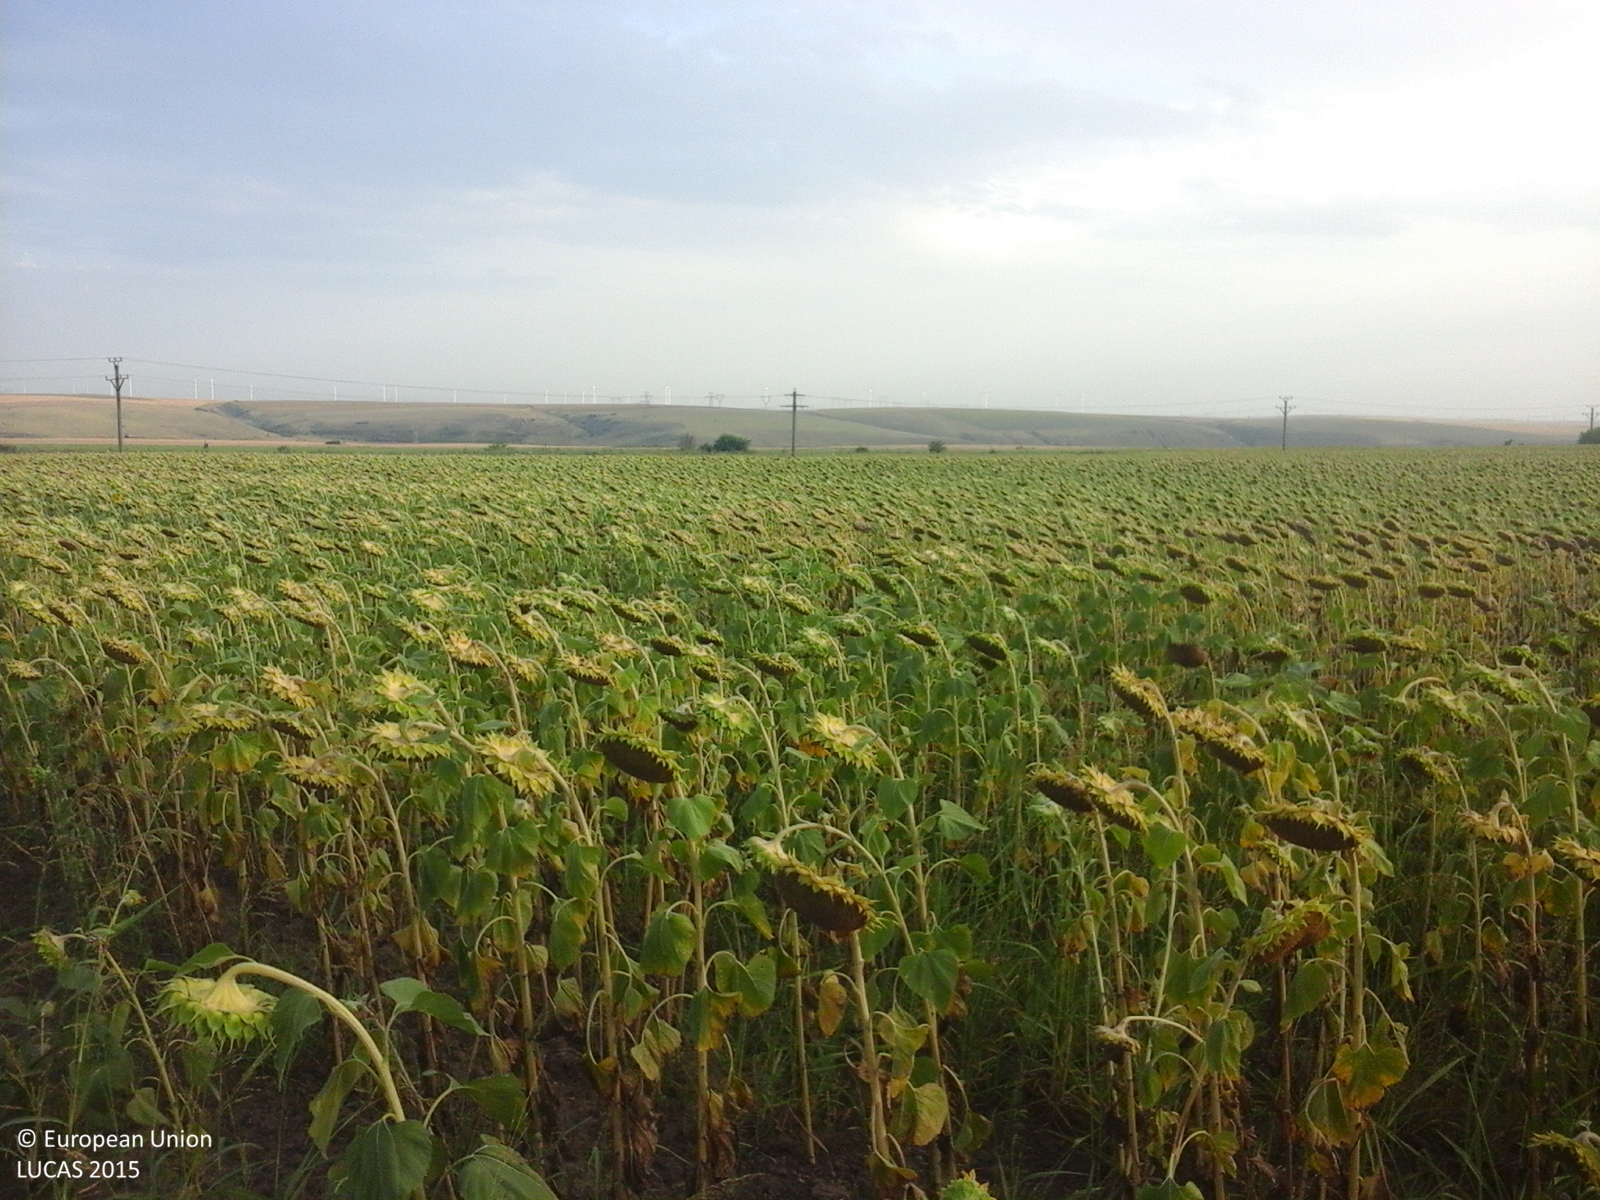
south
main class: Cropland
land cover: Sunflower
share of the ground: > 75 %
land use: Agriculture (excluding fallow land and kitchen gardens)
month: August
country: RO
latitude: 44.3981
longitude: 28.1270
